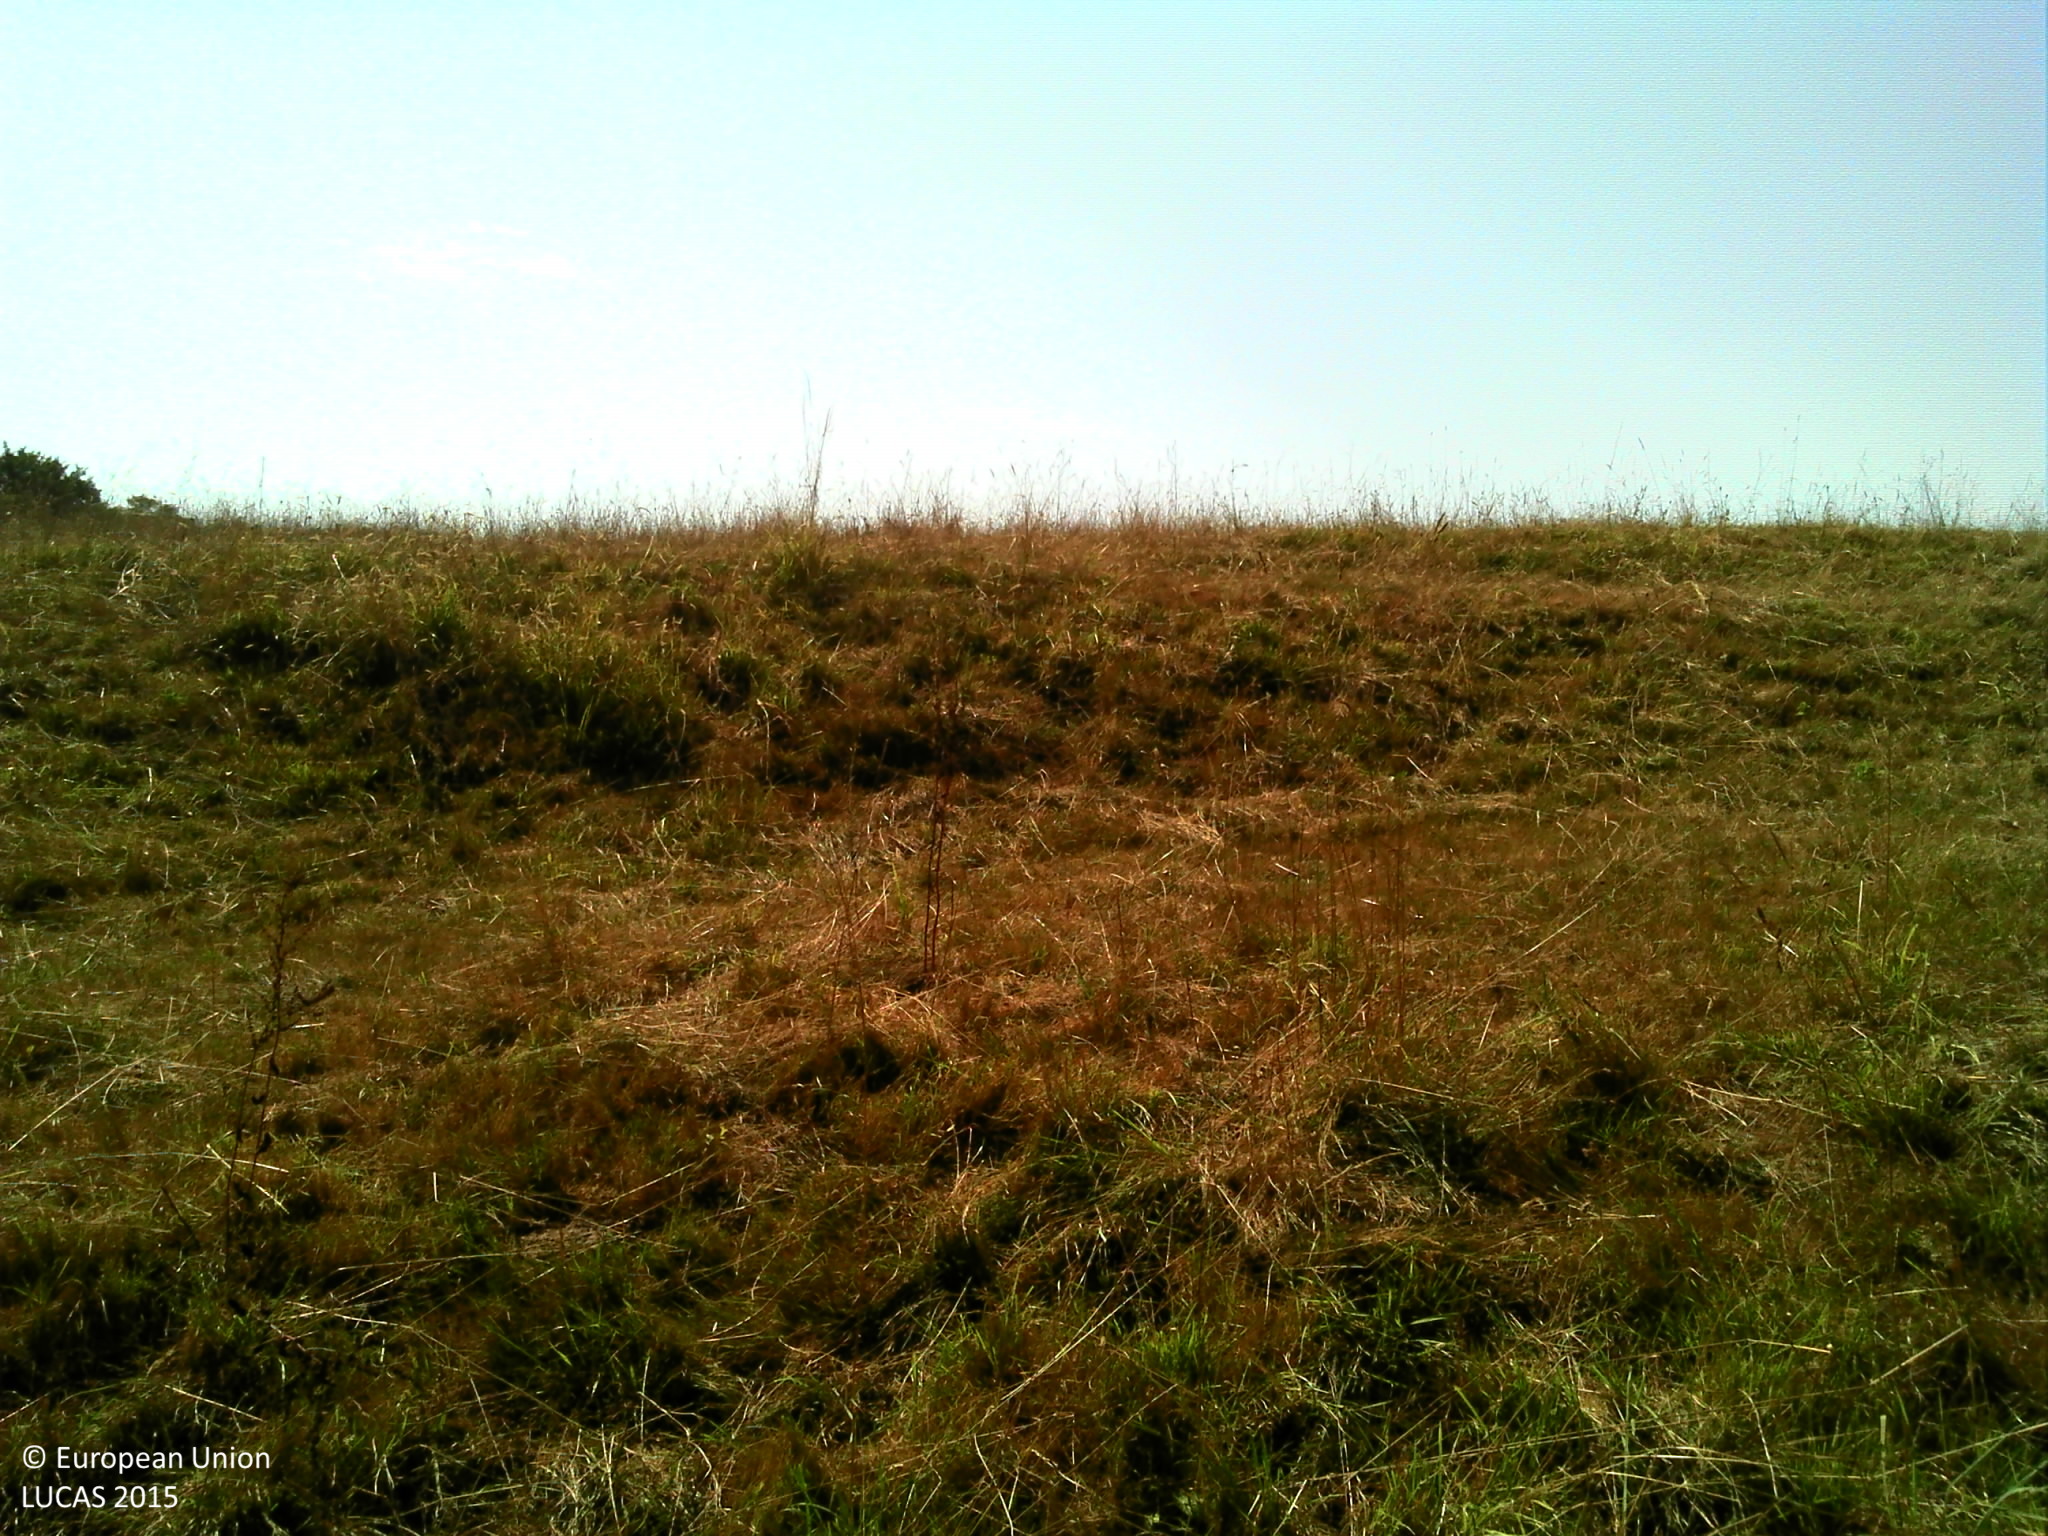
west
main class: Grassland
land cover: Grassland without tree/shrub cover
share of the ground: > 75 %
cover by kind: herbaceous plants 100 %
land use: Agriculture (excluding fallow land and kitchen gardens)
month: August
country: FR
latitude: 45.3987
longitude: 1.0876
